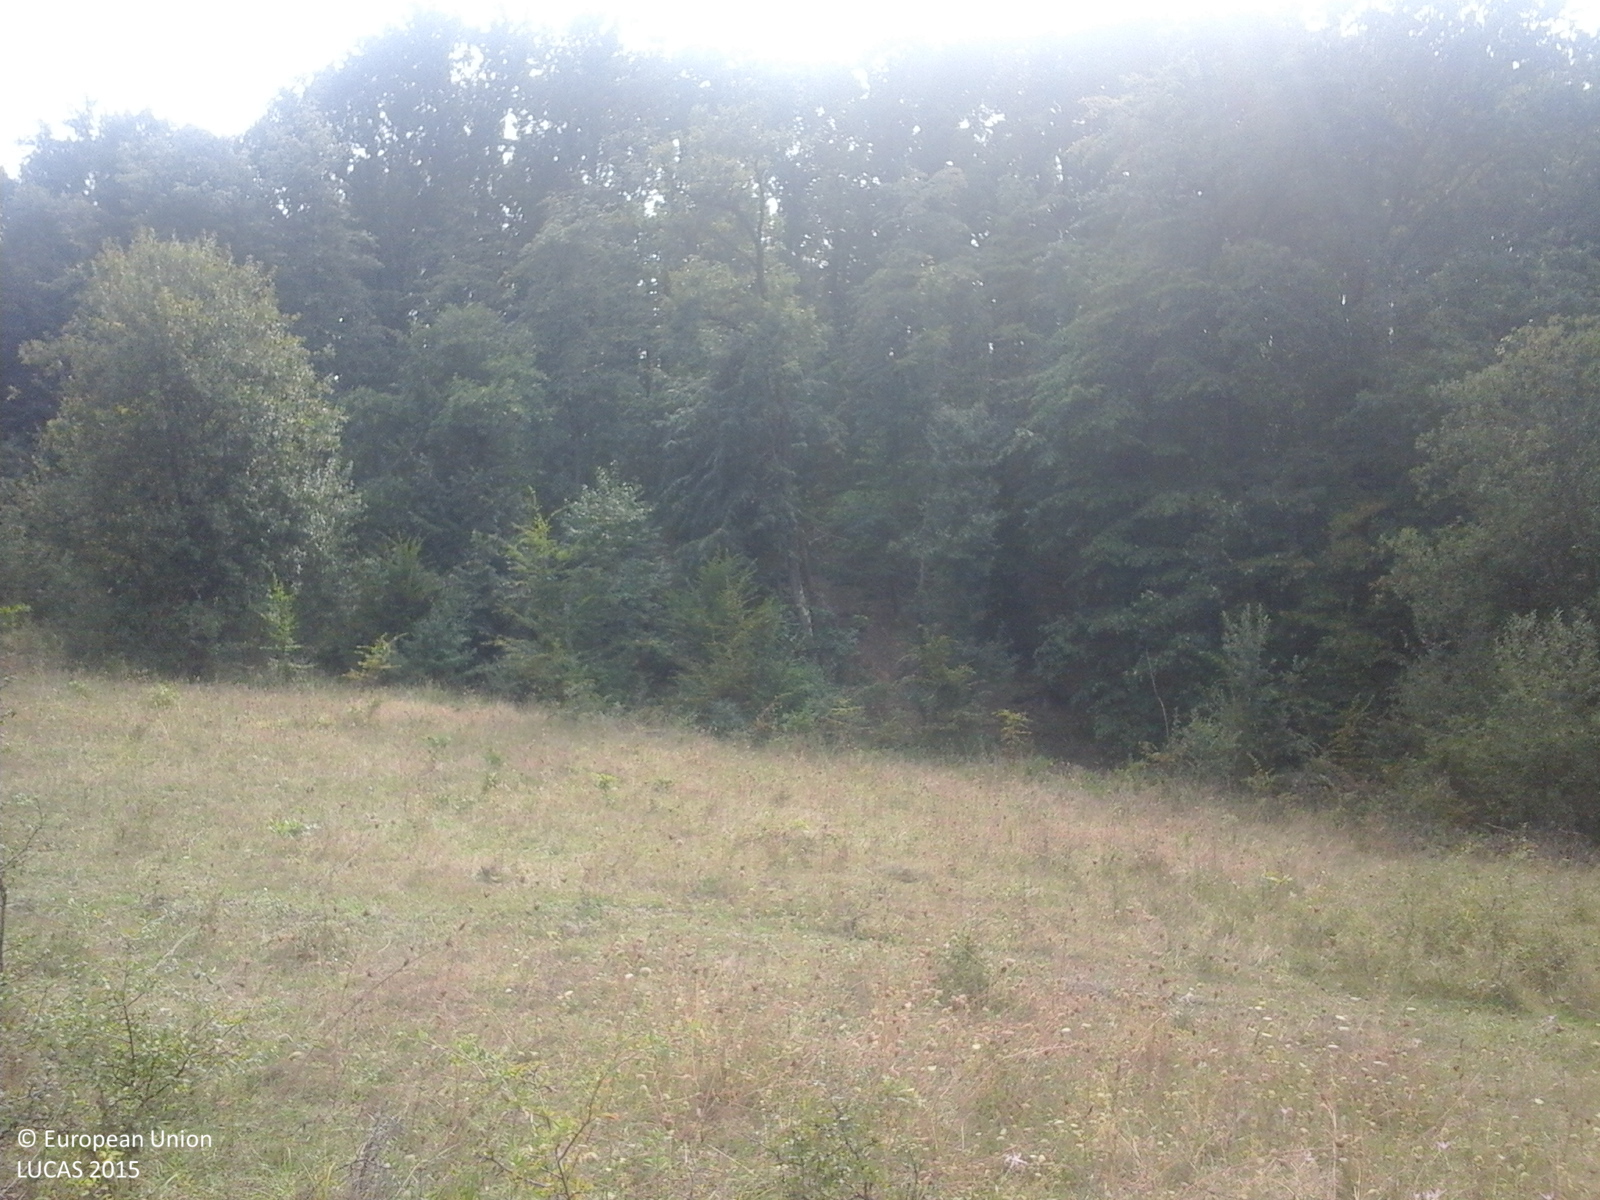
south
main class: Grassland
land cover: Spontaneously vegetated surfaces
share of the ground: > 75 %
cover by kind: herbaceous plants 100 %
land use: Fallow land
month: September
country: RO
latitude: 47.0907
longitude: 23.2536
